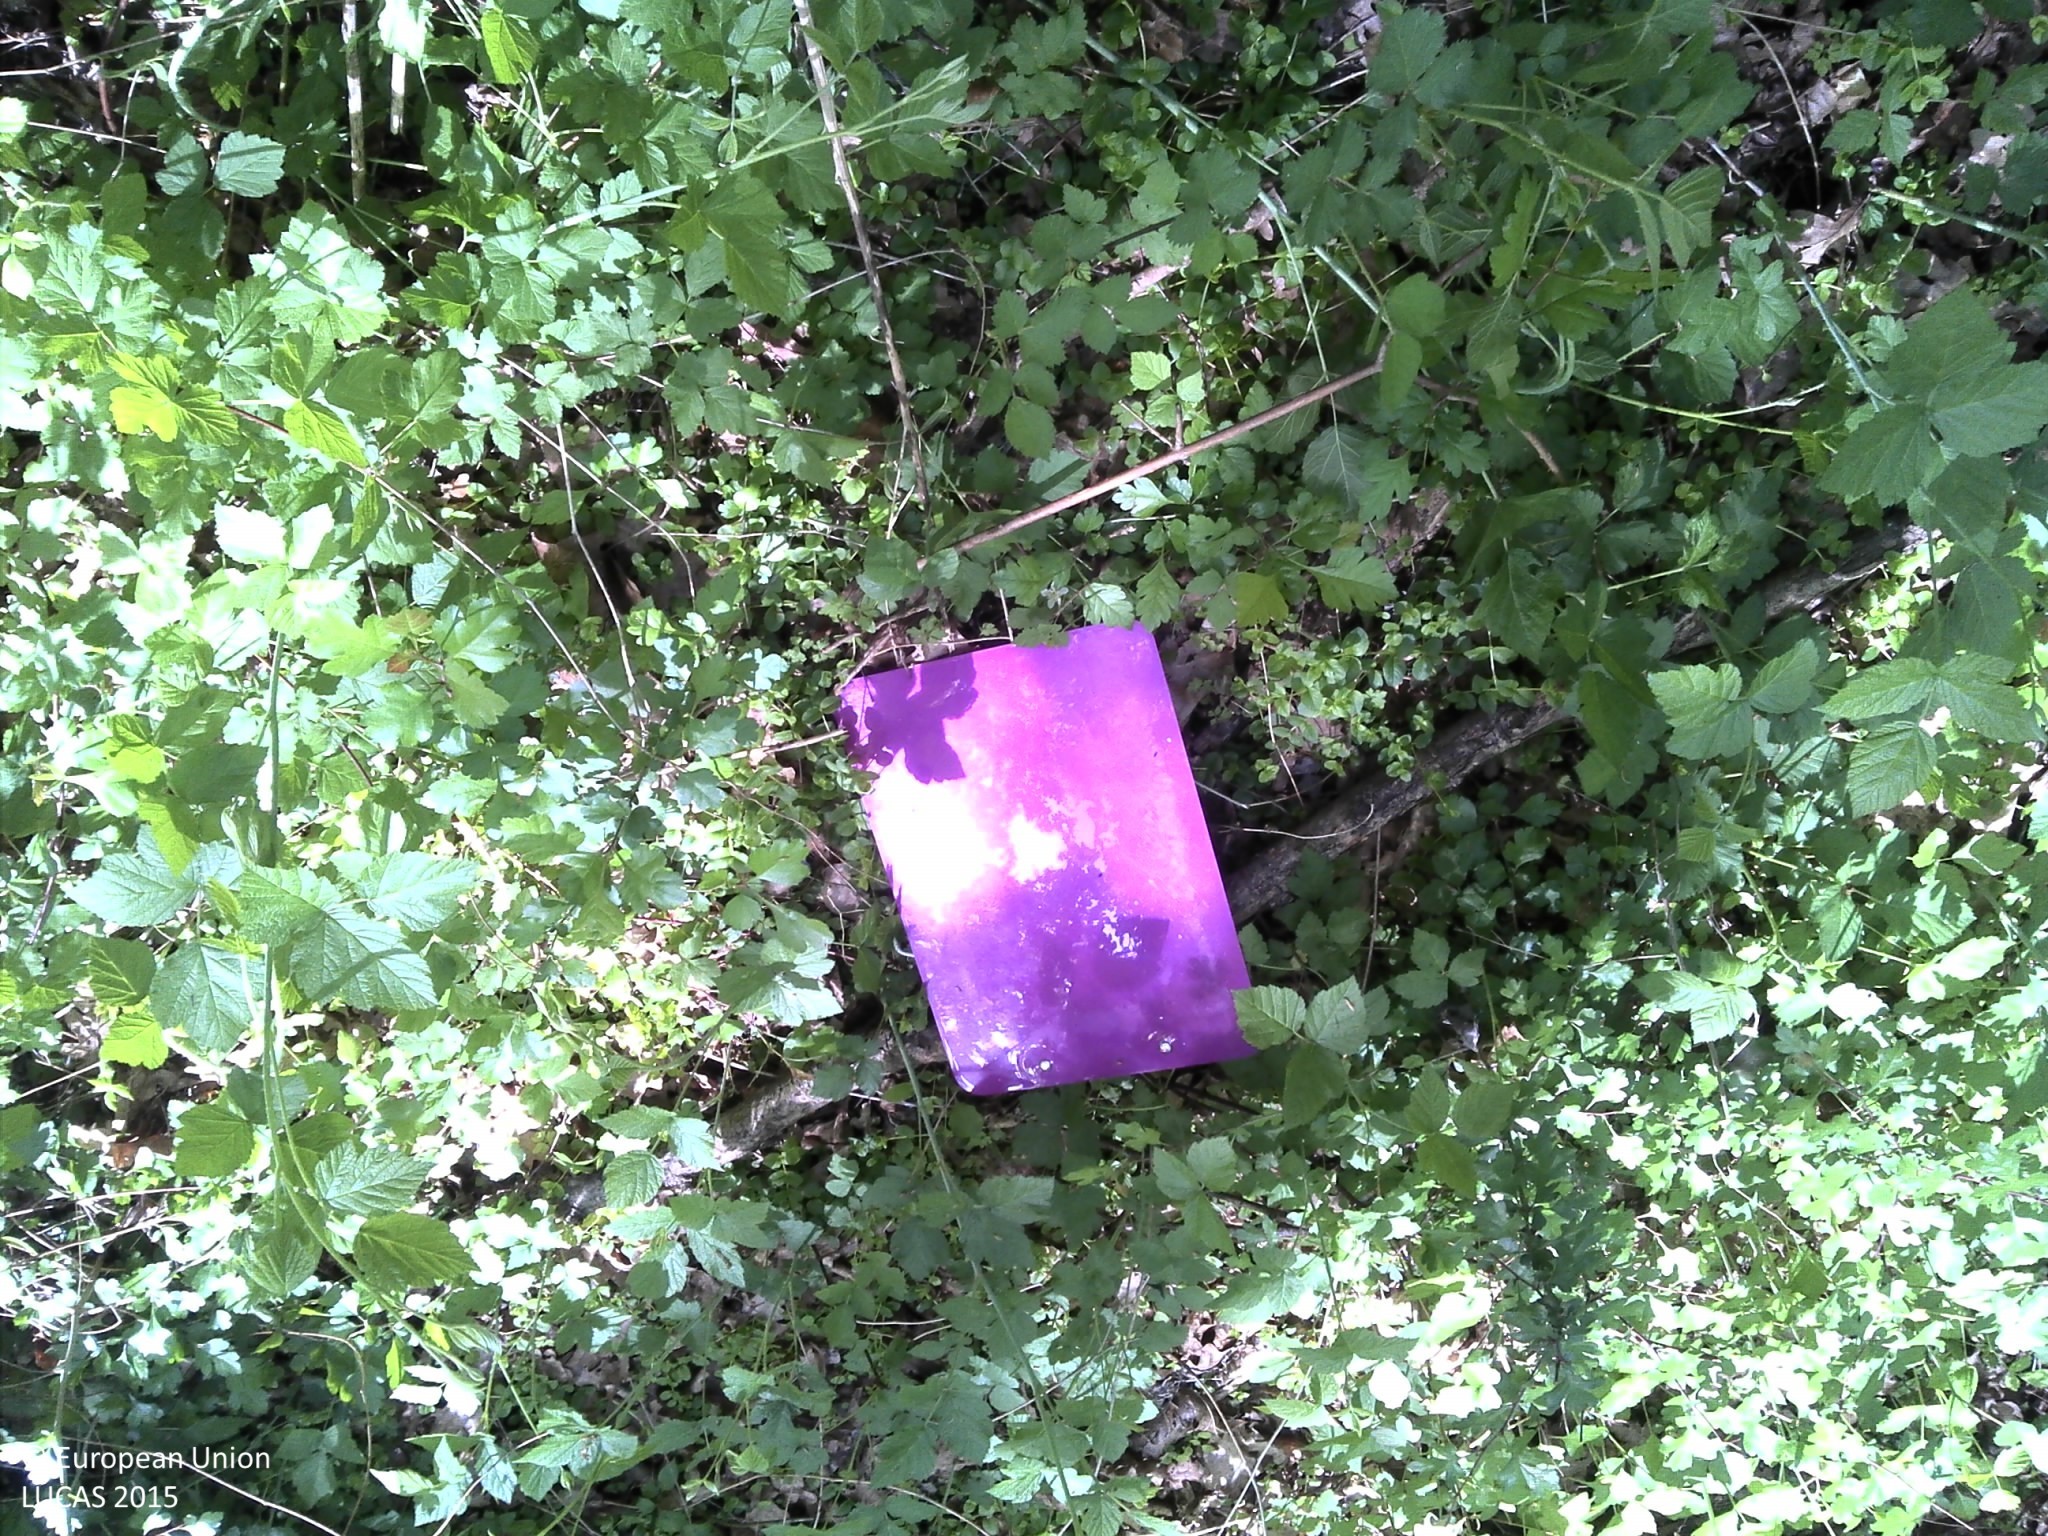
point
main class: Woodland
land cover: Broadleaved woodland
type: acidophilous oak and oak-birch forest
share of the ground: > 75 %
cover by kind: broadleaved forest trees 100 %
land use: Forestry
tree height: > 5 m
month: May
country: HR
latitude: 45.1158
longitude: 18.6110
